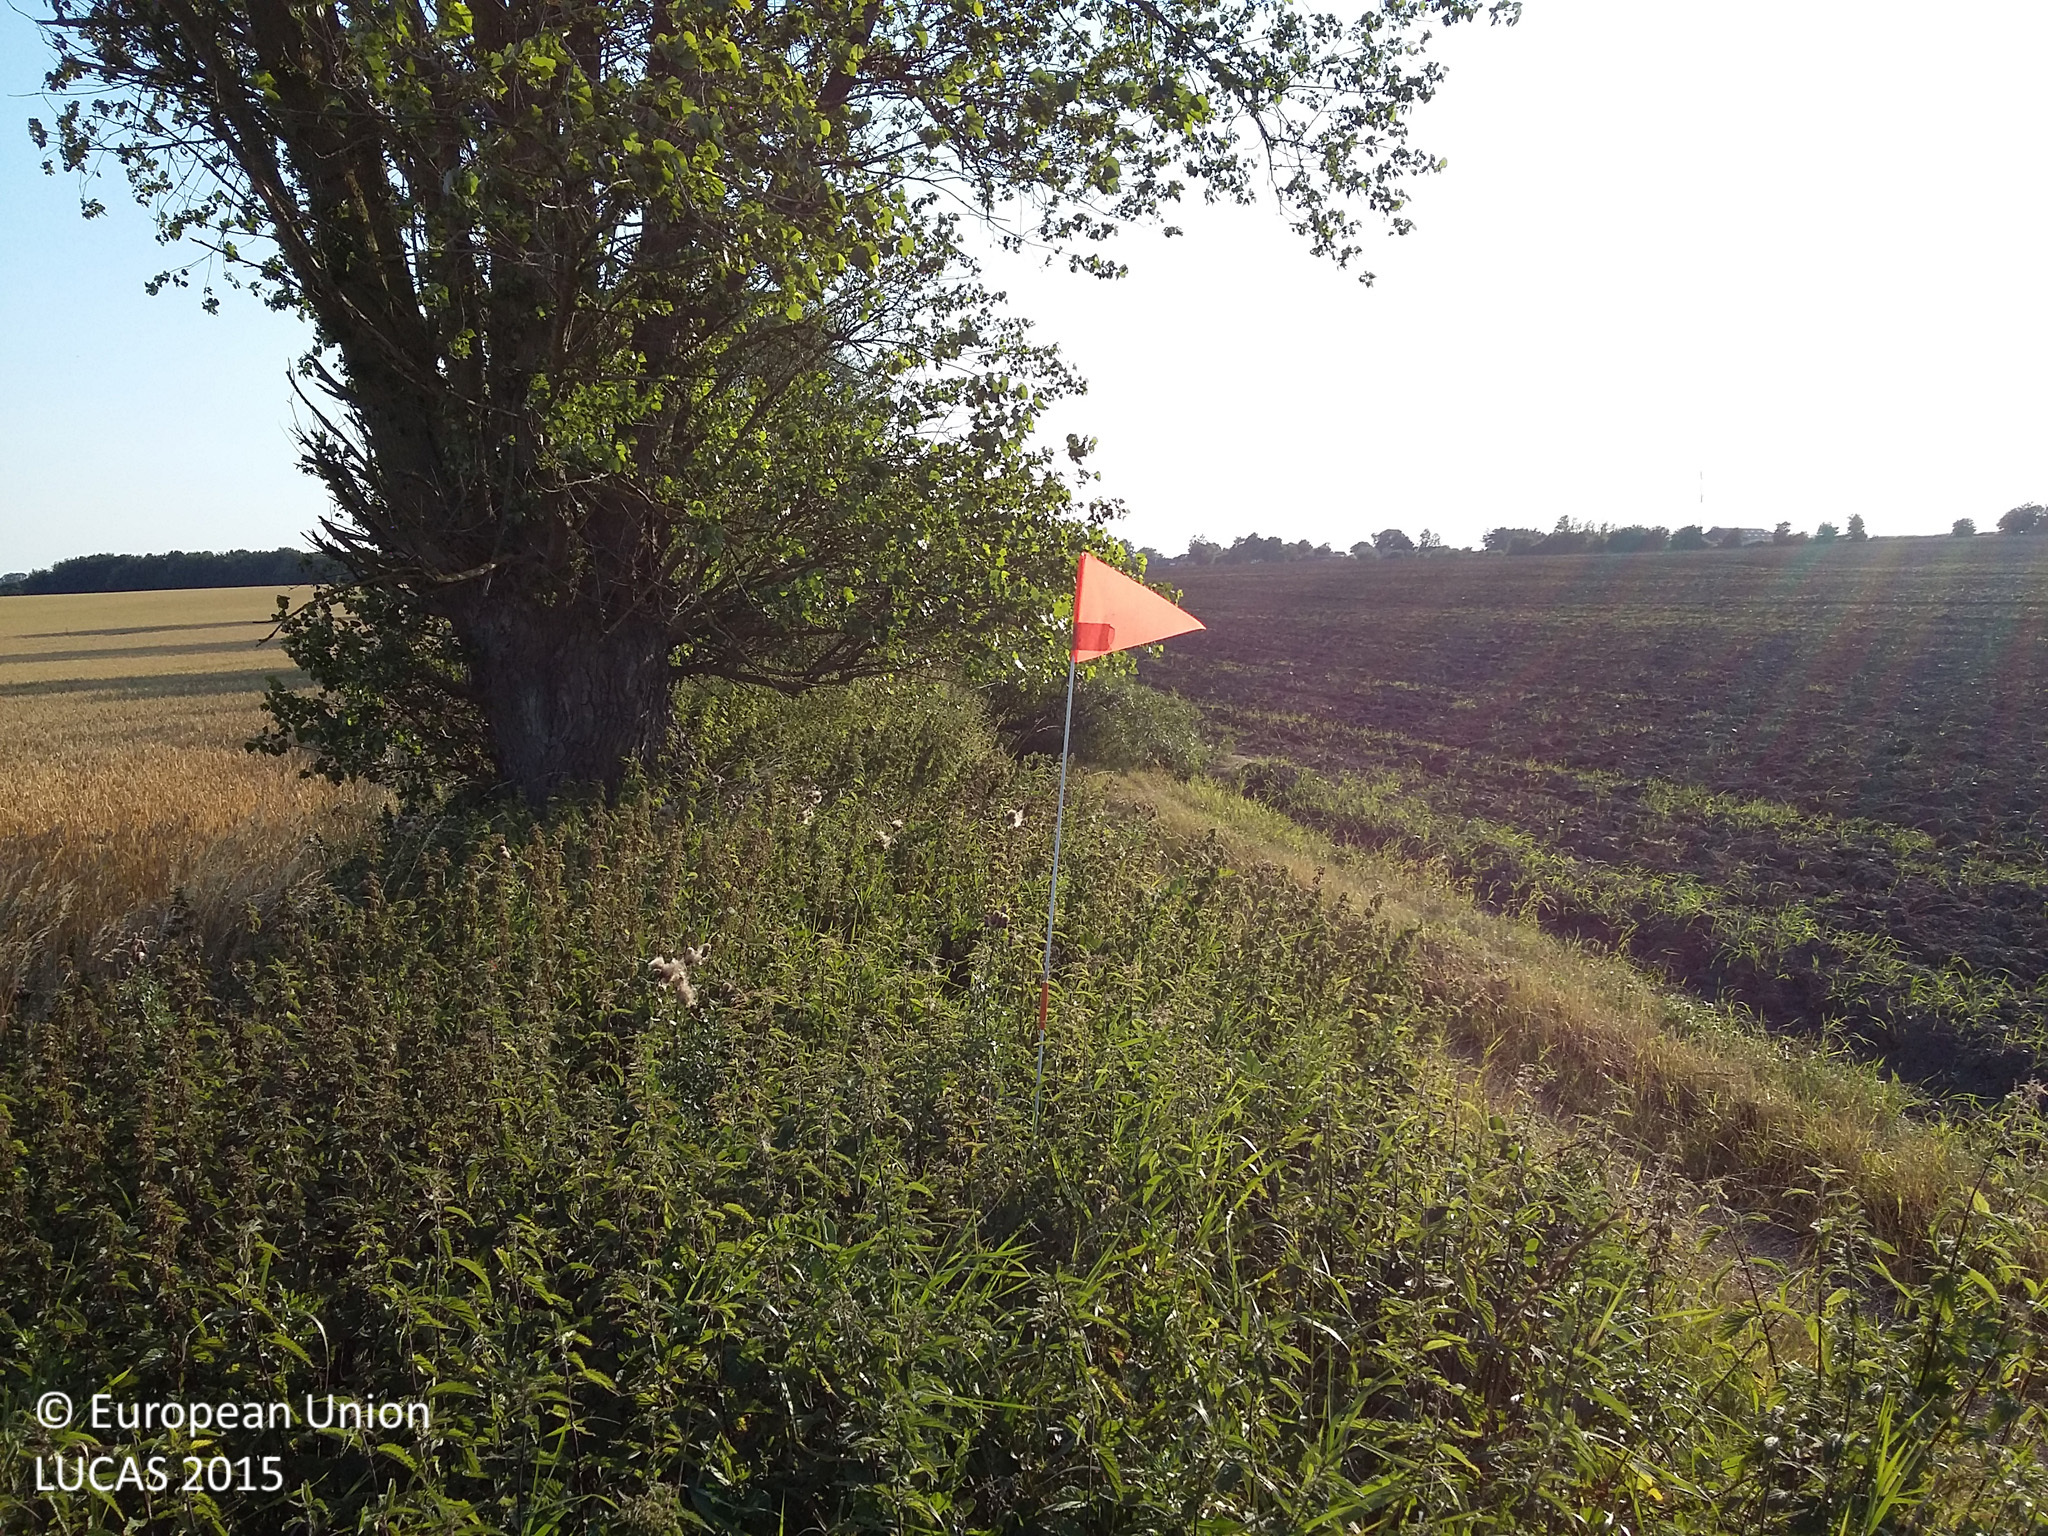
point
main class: Woodland
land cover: Broadleaved woodland
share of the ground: 25 - 50 %
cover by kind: herbaceous plants 60 %, broadleaved forest trees 40 %
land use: Agriculture (excluding fallow land and kitchen gardens)
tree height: > 5 m
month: August
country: DK
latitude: 55.6294
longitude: 12.2059
